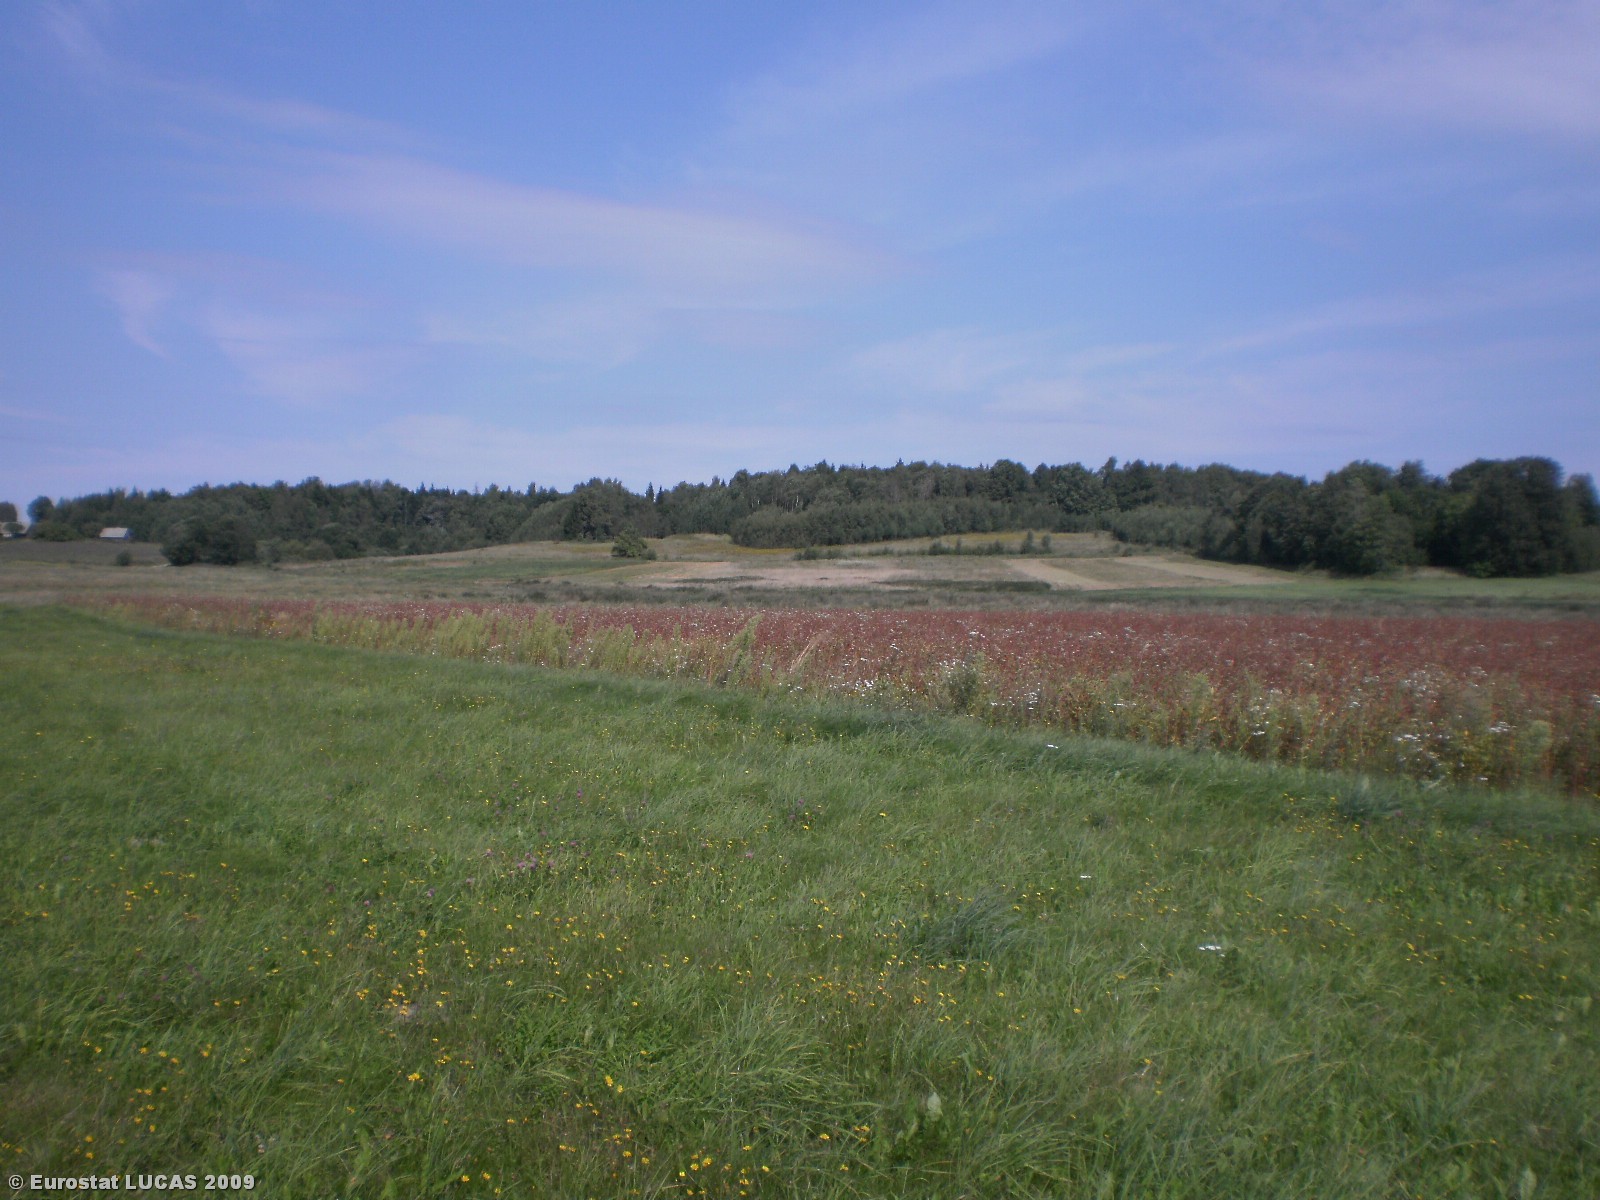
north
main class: Grassland
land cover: Grassland without tree/shrub cover
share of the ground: > 75 %
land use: Agriculture (excluding fallow land and kitchen gardens)
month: August
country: LT
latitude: 55.0648
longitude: 24.8119
